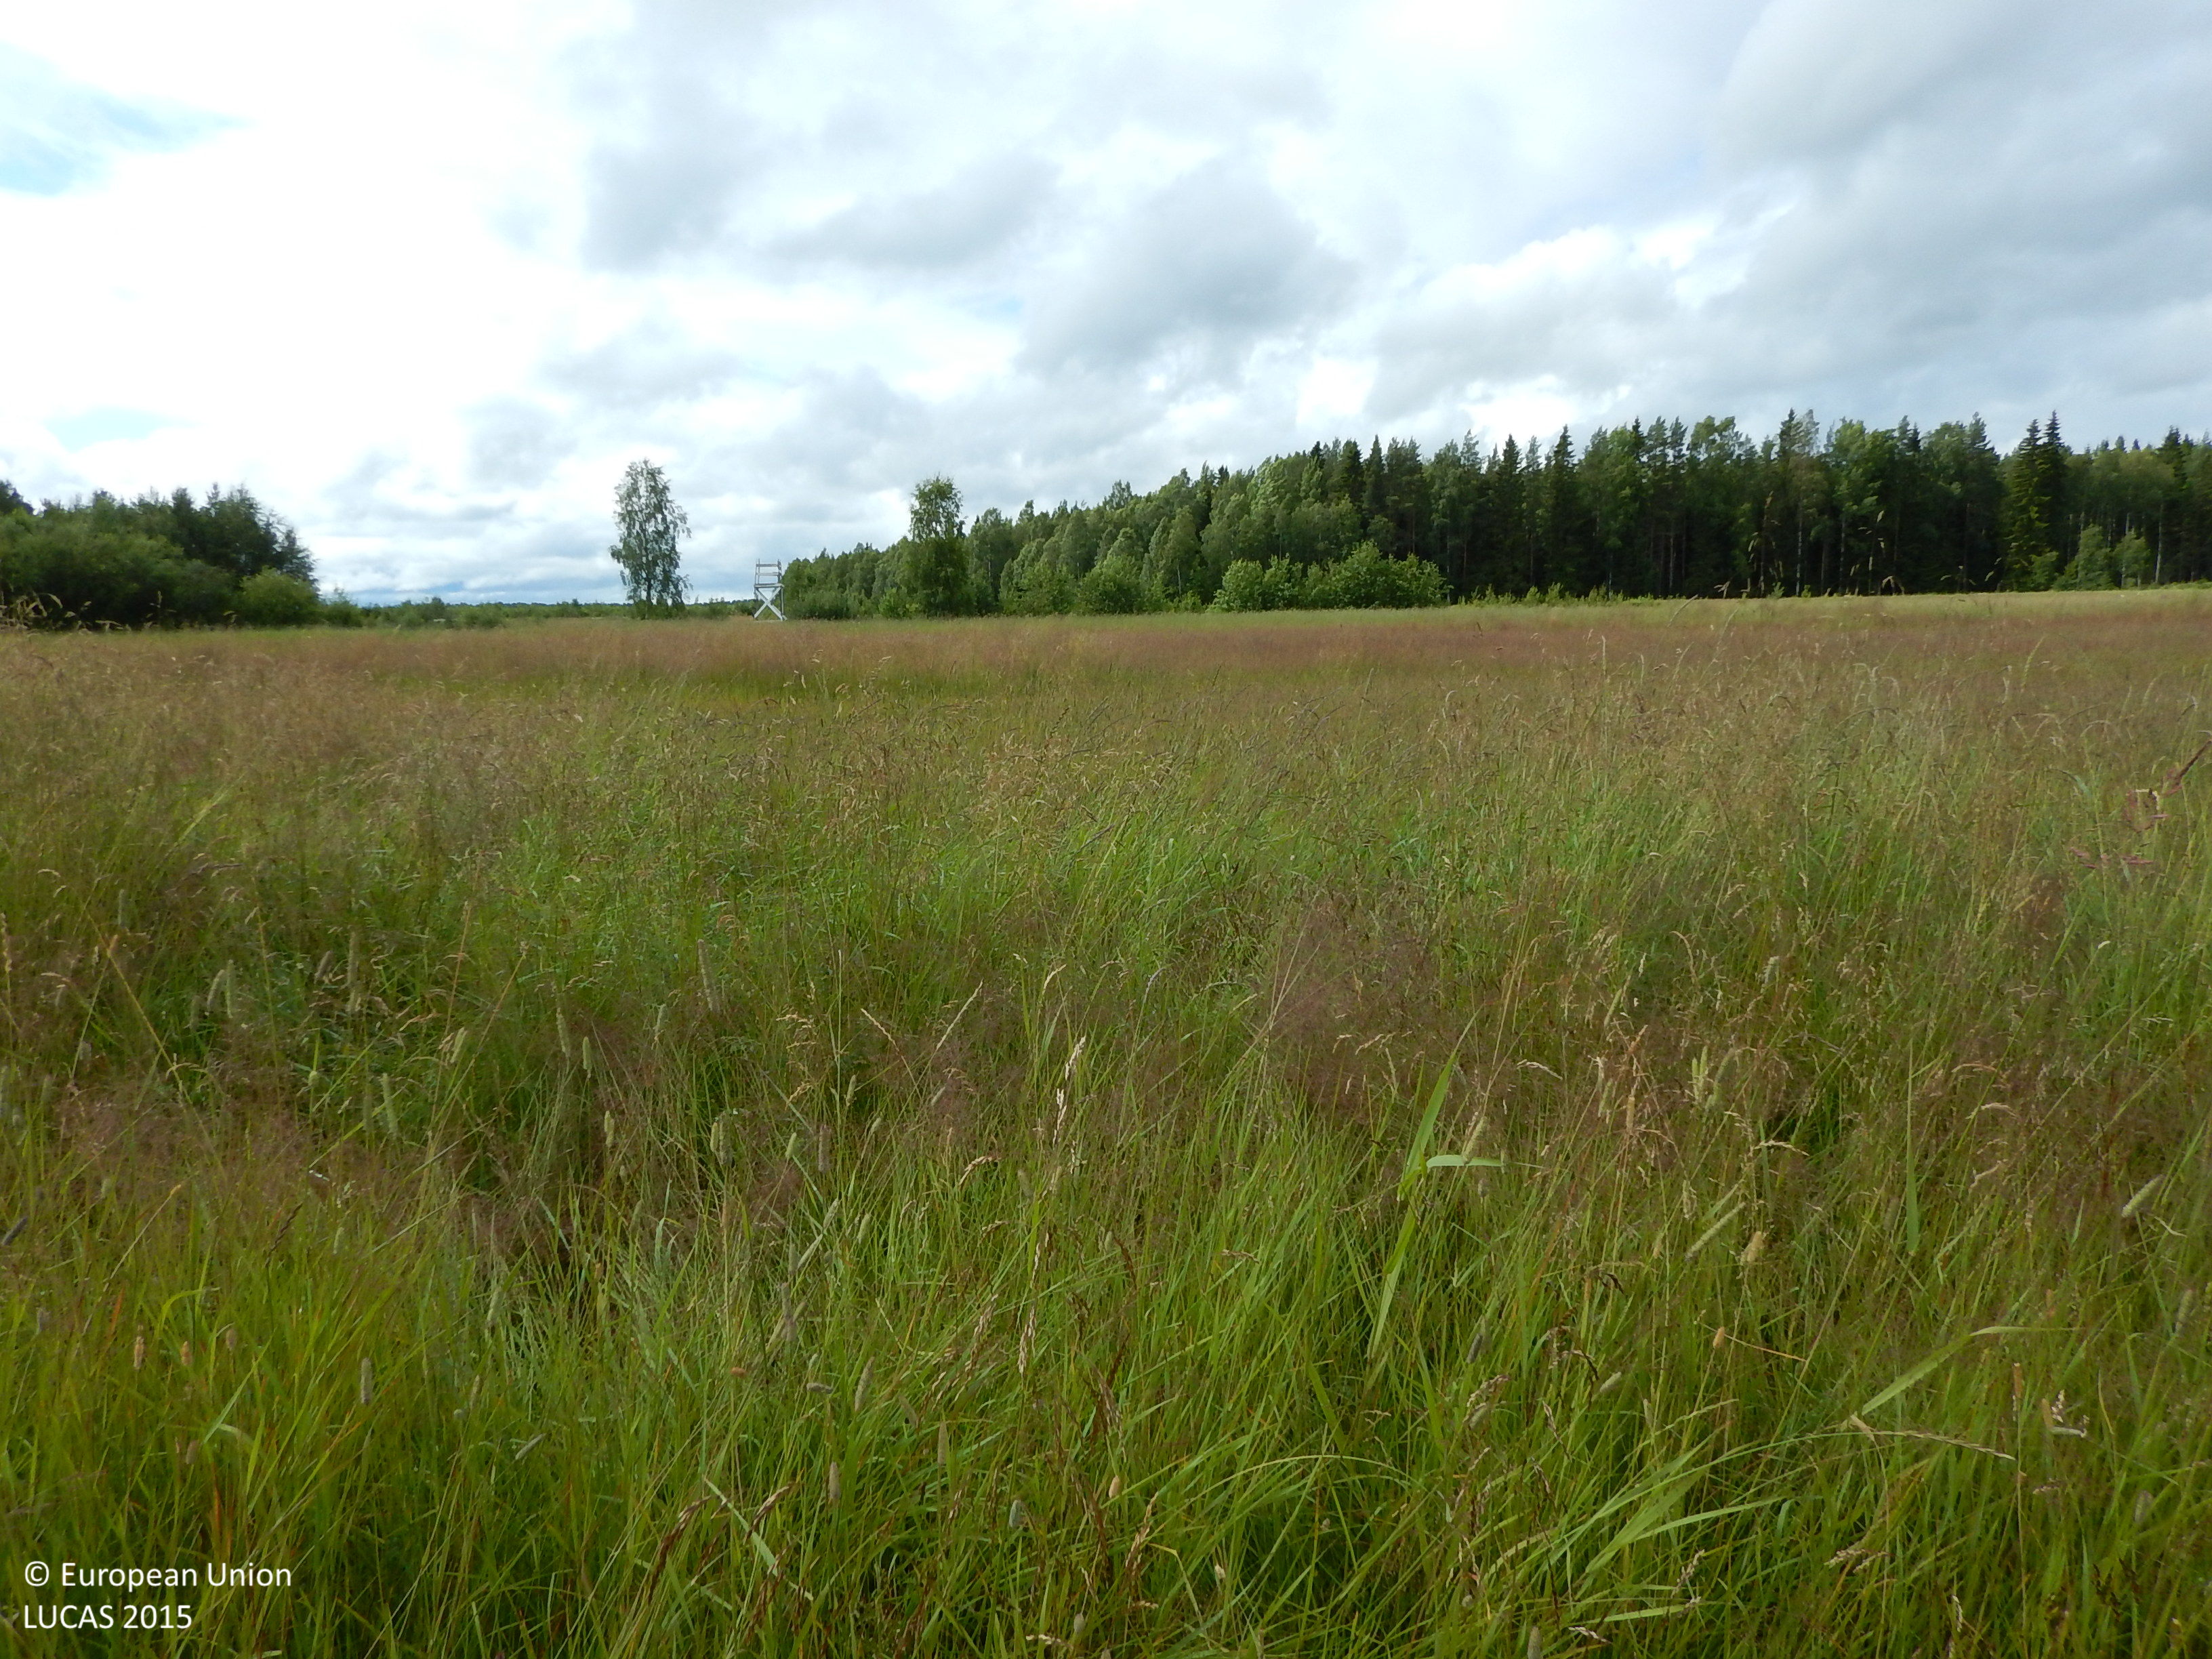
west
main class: Grassland
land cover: Grassland without tree/shrub cover
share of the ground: > 75 %
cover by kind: herbaceous plants 100 %
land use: Agriculture (excluding fallow land and kitchen gardens)
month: July
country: SE
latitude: 64.7621
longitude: 20.7596
